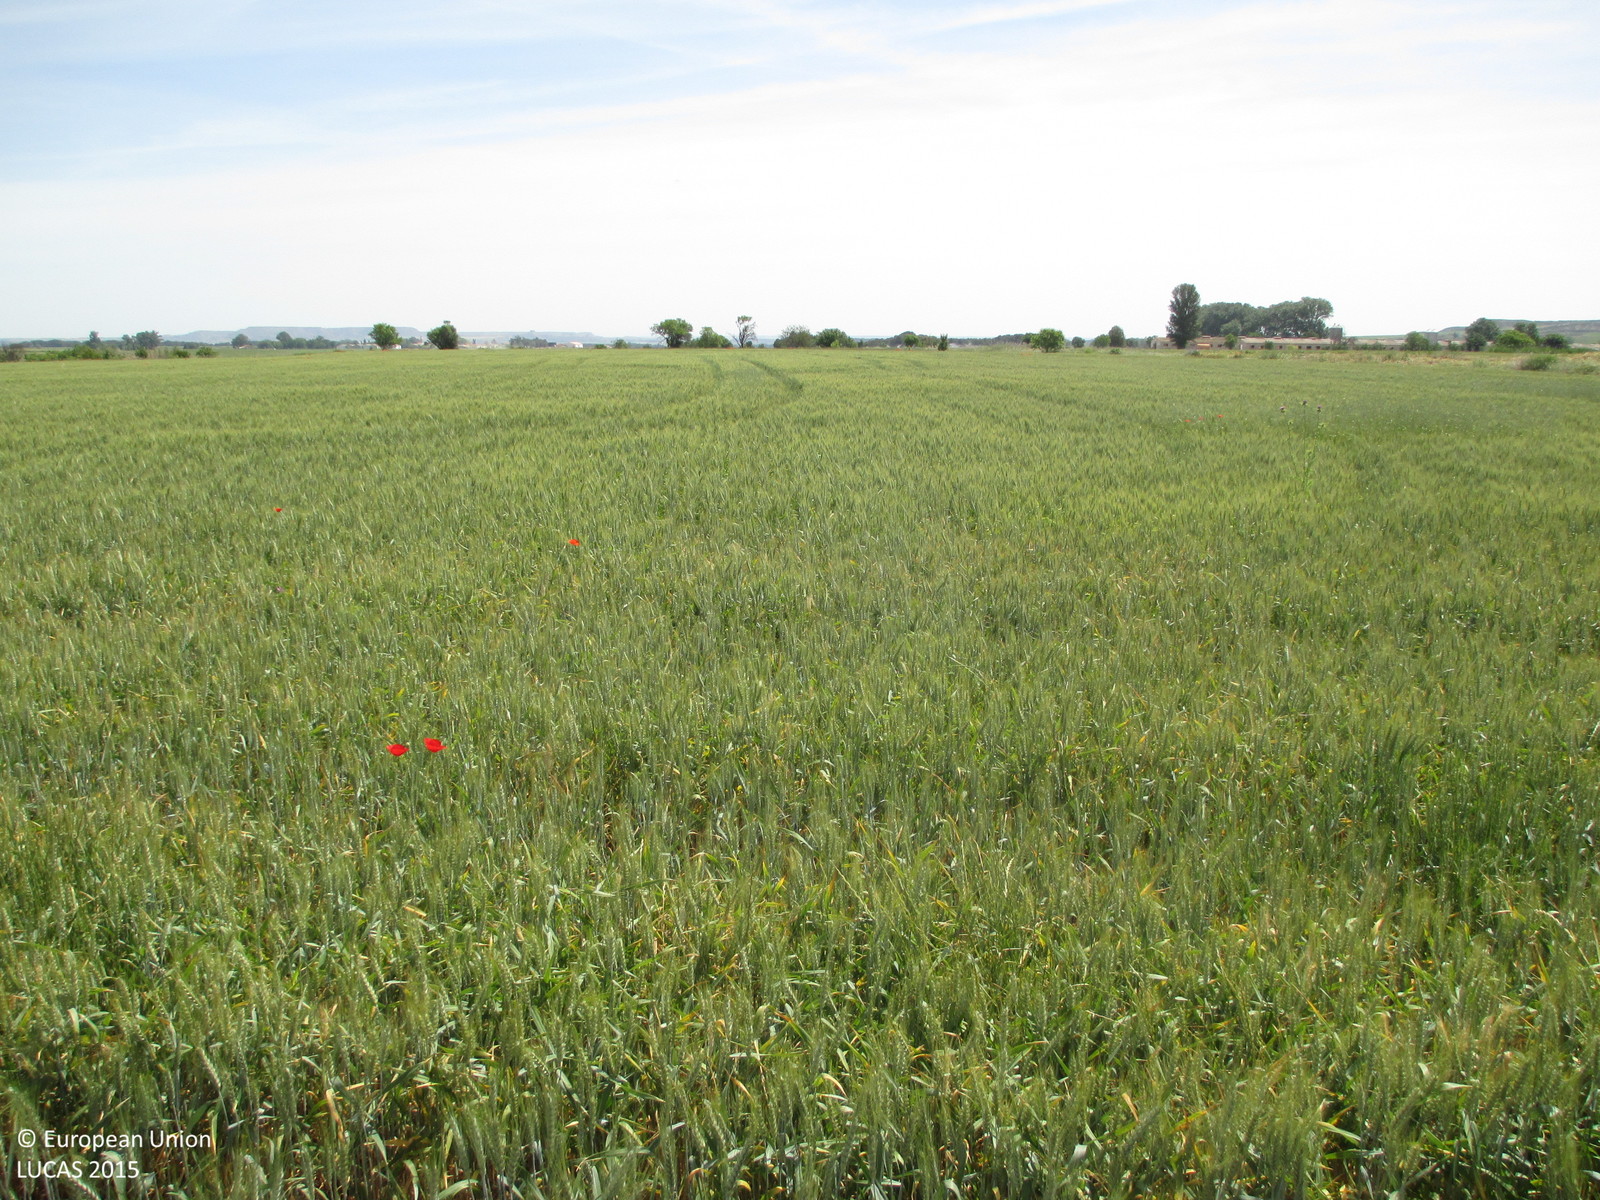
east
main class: Grassland
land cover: Spontaneously vegetated surfaces
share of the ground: > 75 %
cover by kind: herbaceous plants 100 %
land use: Agriculture (excluding fallow land and kitchen gardens)
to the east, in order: Spontaneously vegetated surfaces; Common wheat; Grass margins; Ditches and canals; Spontaneously vegetated surfaces; Grass margins; Ditches and canals; Grass margins; Barley; Shruby margins; Single bushes/trees; Common wheat
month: May
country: ES
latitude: 41.8786
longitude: -0.4195
